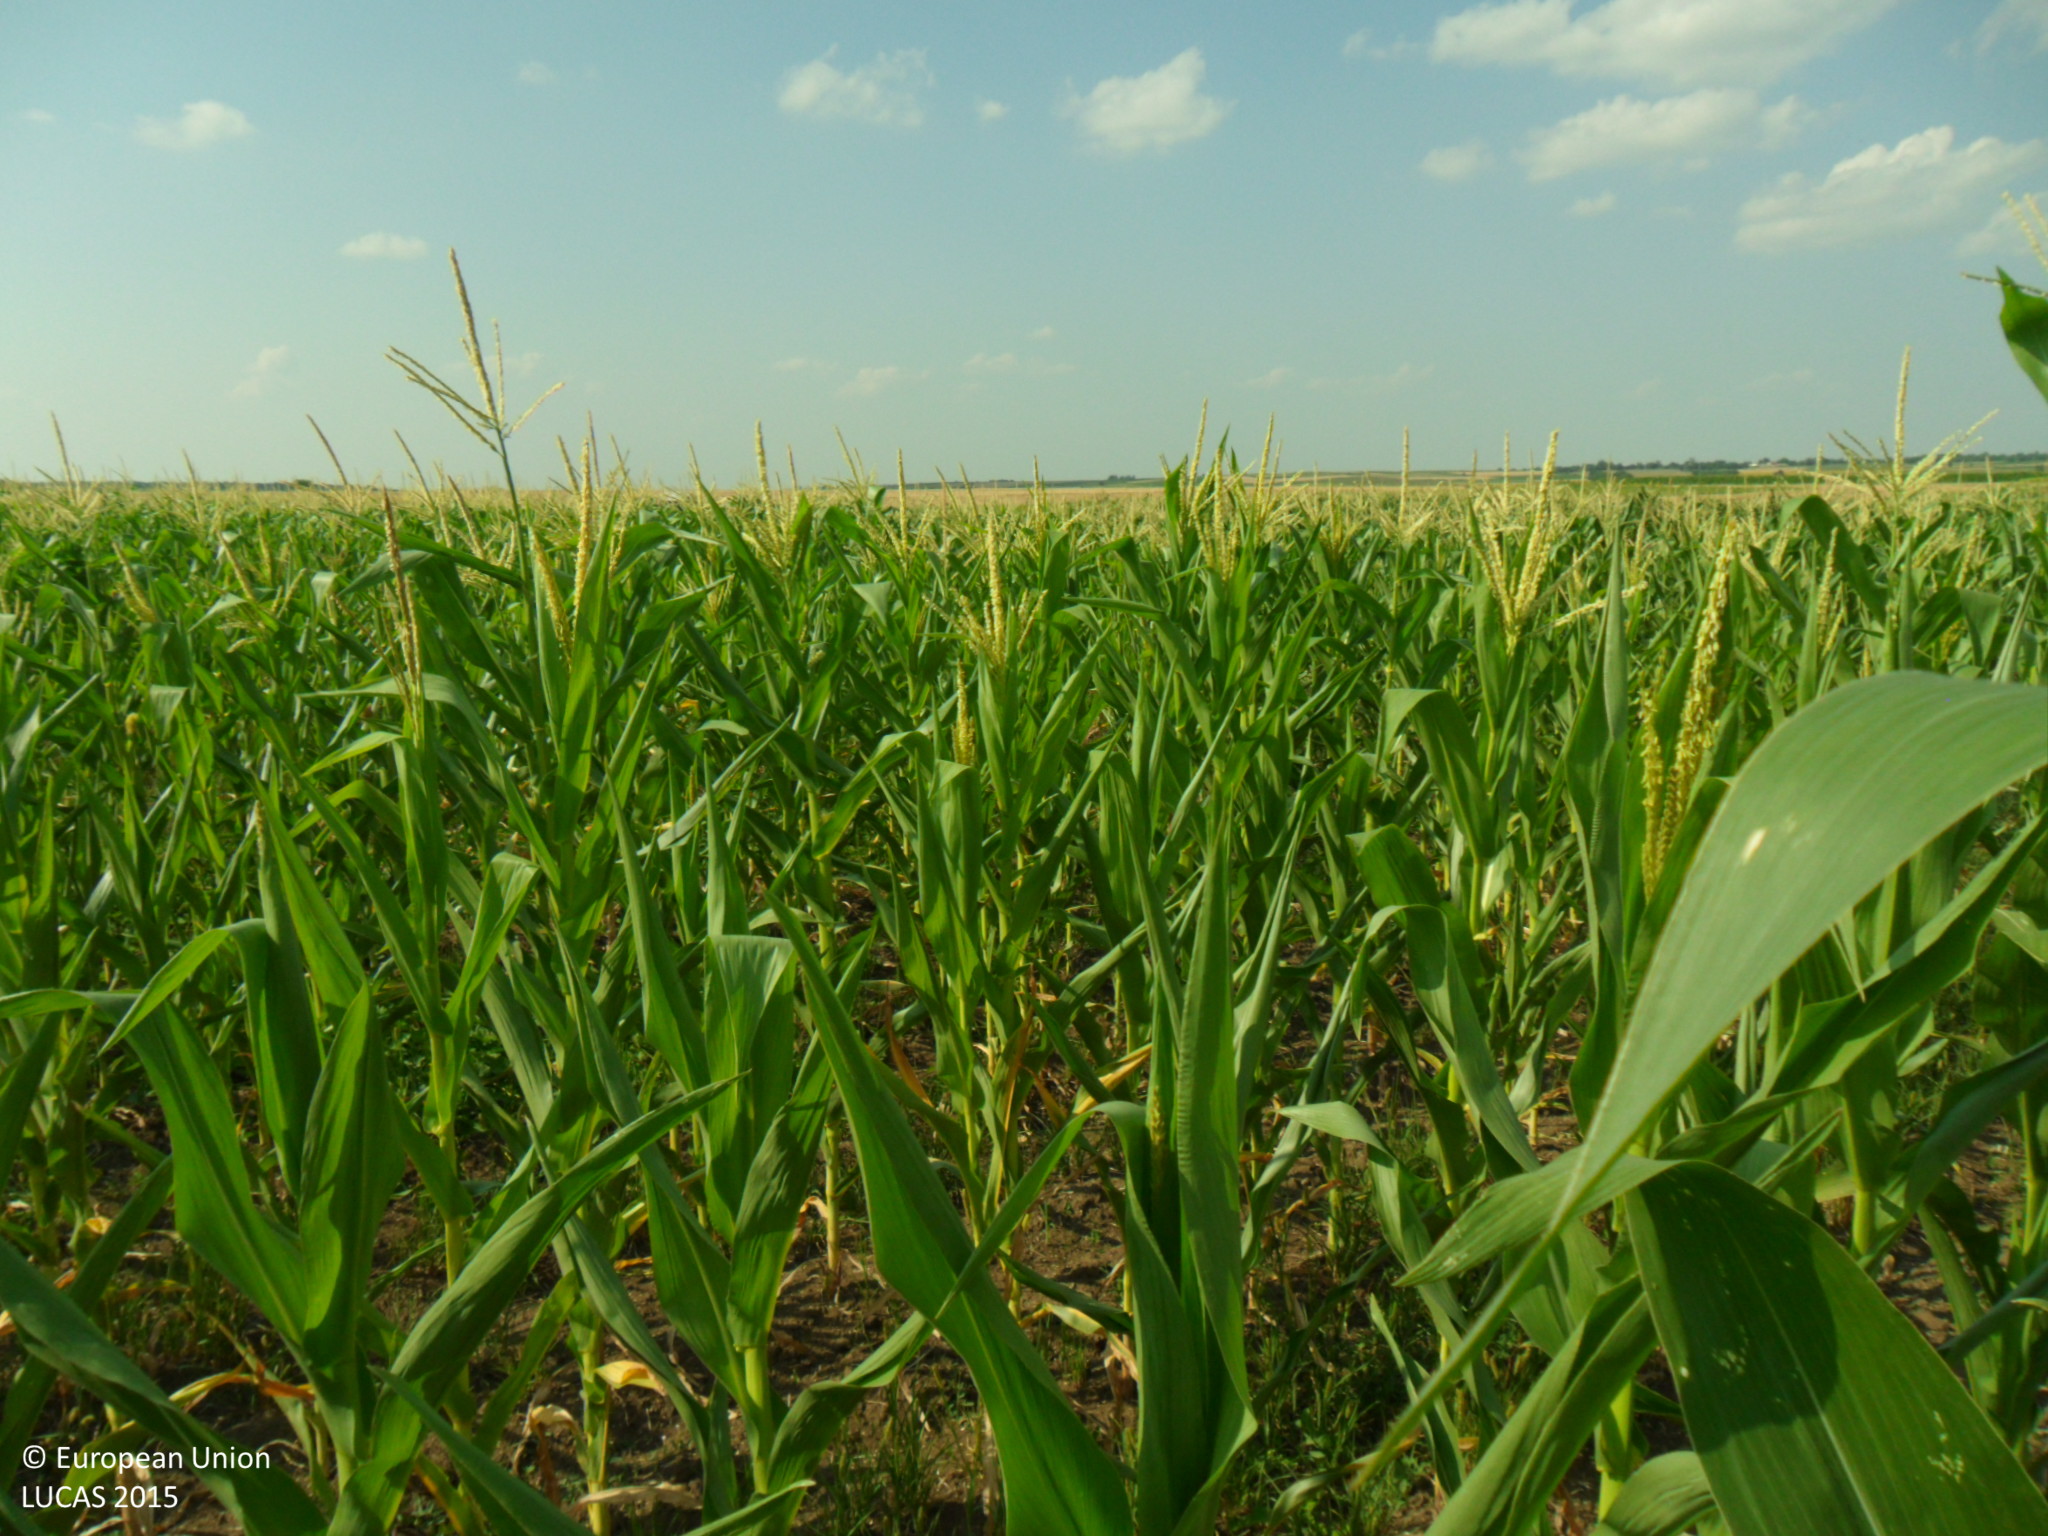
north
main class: Cropland
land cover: Maize
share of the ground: > 75 %
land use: Agriculture (excluding fallow land and kitchen gardens)
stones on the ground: < 10 %
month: July
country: BG
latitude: 43.6457
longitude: 27.0427
